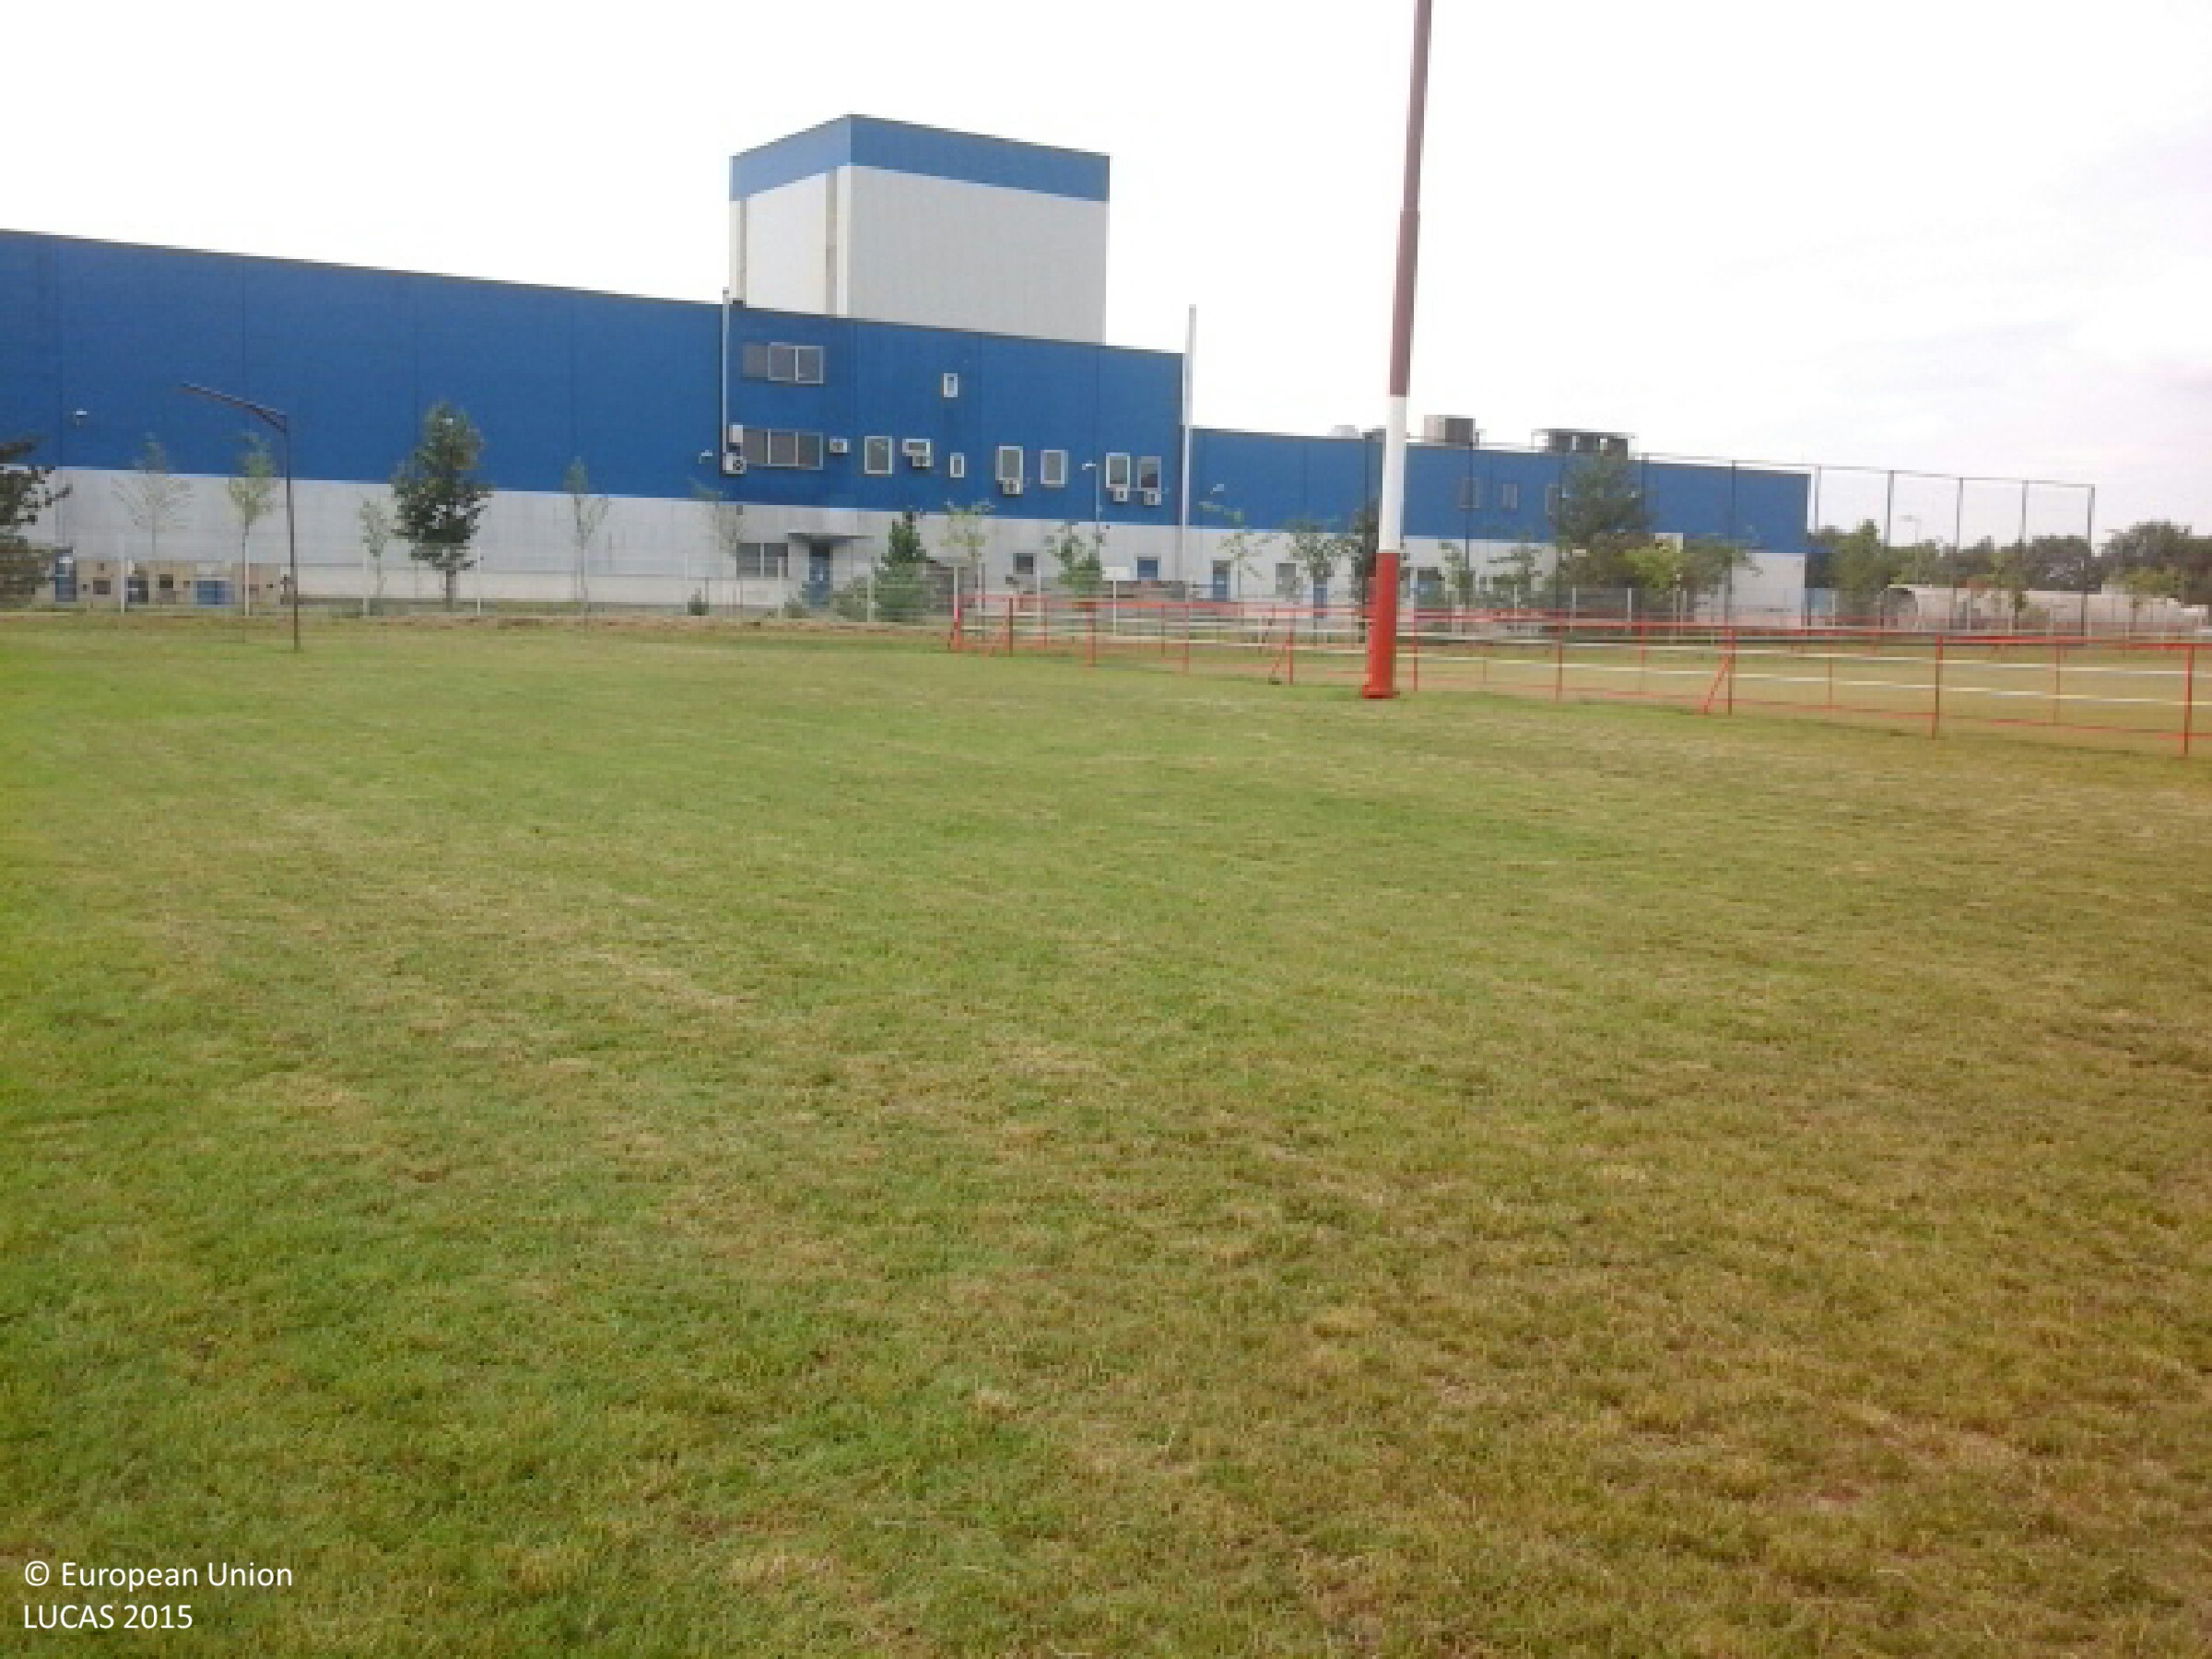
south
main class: Grassland
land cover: Grassland without tree/shrub cover
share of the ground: > 75 %
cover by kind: herbaceous plants 100 %
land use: Sport
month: June
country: HU
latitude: 47.4301
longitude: 19.0994
